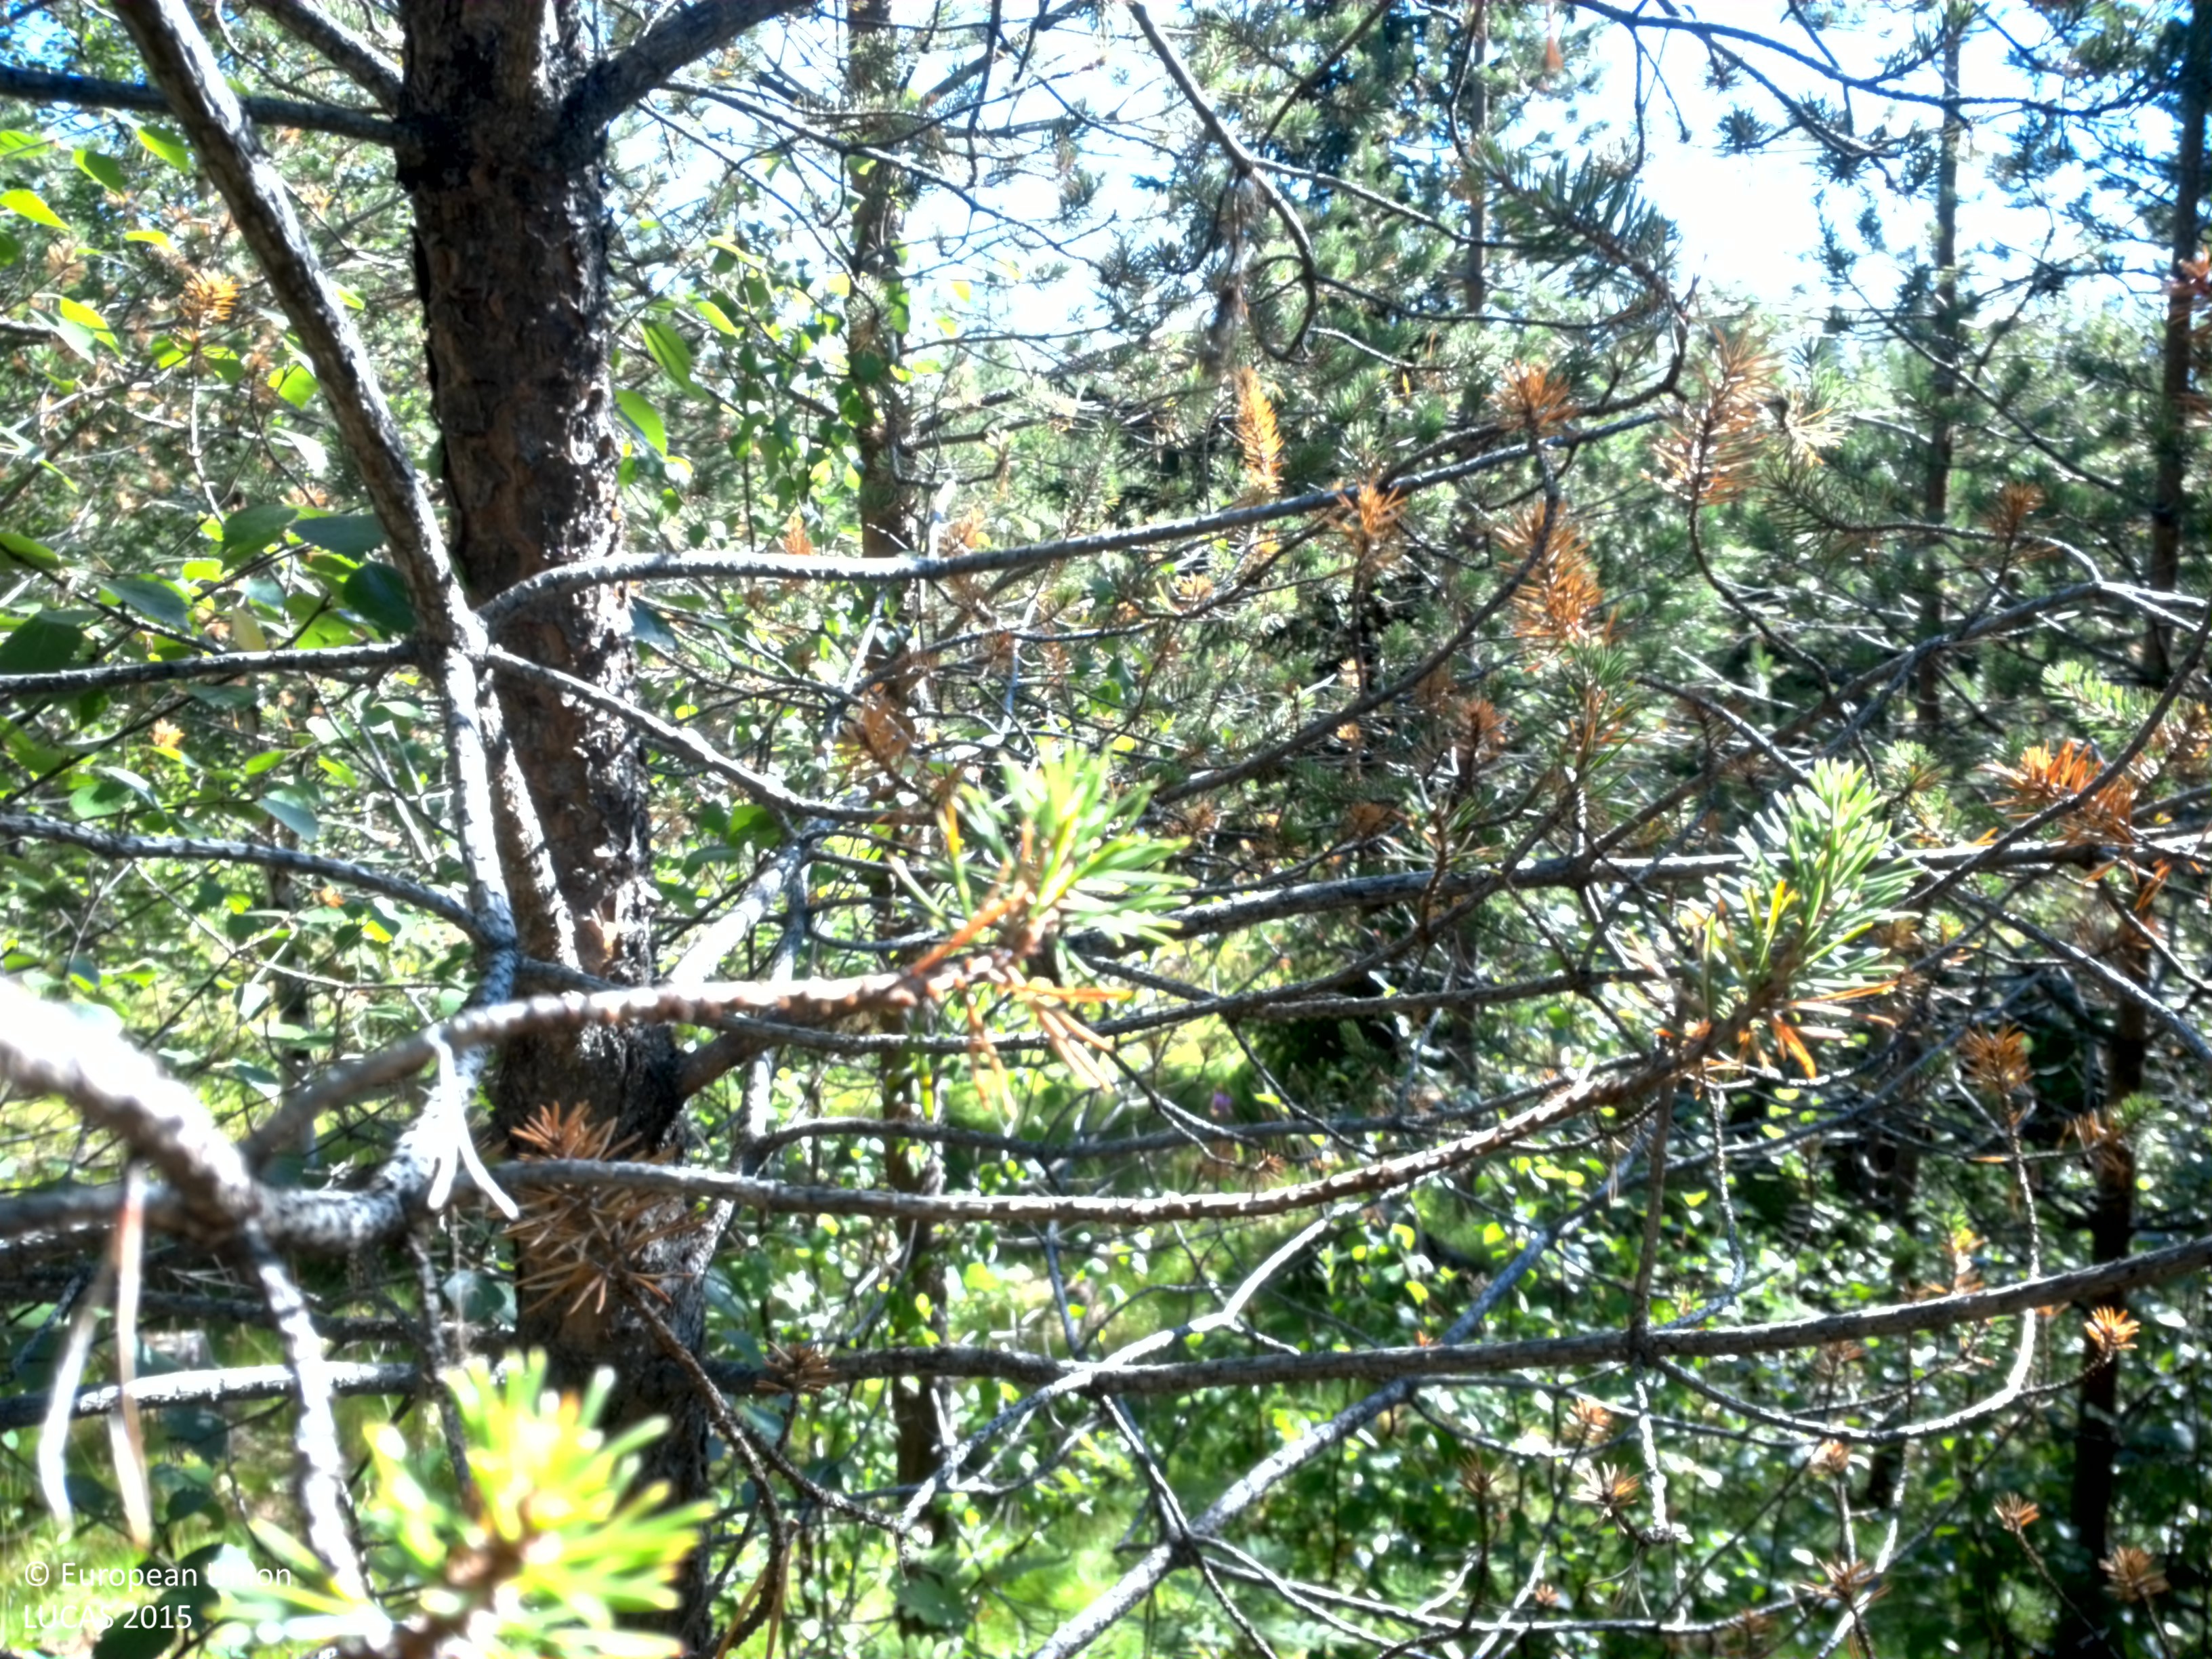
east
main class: Woodland
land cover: Pine dominated coniferous woodland
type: boreal forest
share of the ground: 50 - 75 %
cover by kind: coniferous forest trees 50 %, herbaceous plants 20 %, shrubs 15 %, lichens and mosses 10 %, broadleaved forest trees 5 %
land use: Forestry
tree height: > 5 m
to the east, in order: Pine dominated coniferous woodland; Tracks; Pine dominated coniferous woodland; Other mixed woodland; Pine dominated coniferous woodland; Other coniferous woodland; Other bare soil; Shrubland with sparse tree cover; Other bare soil
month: August
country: SE
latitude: 64.7902
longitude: 16.0481
